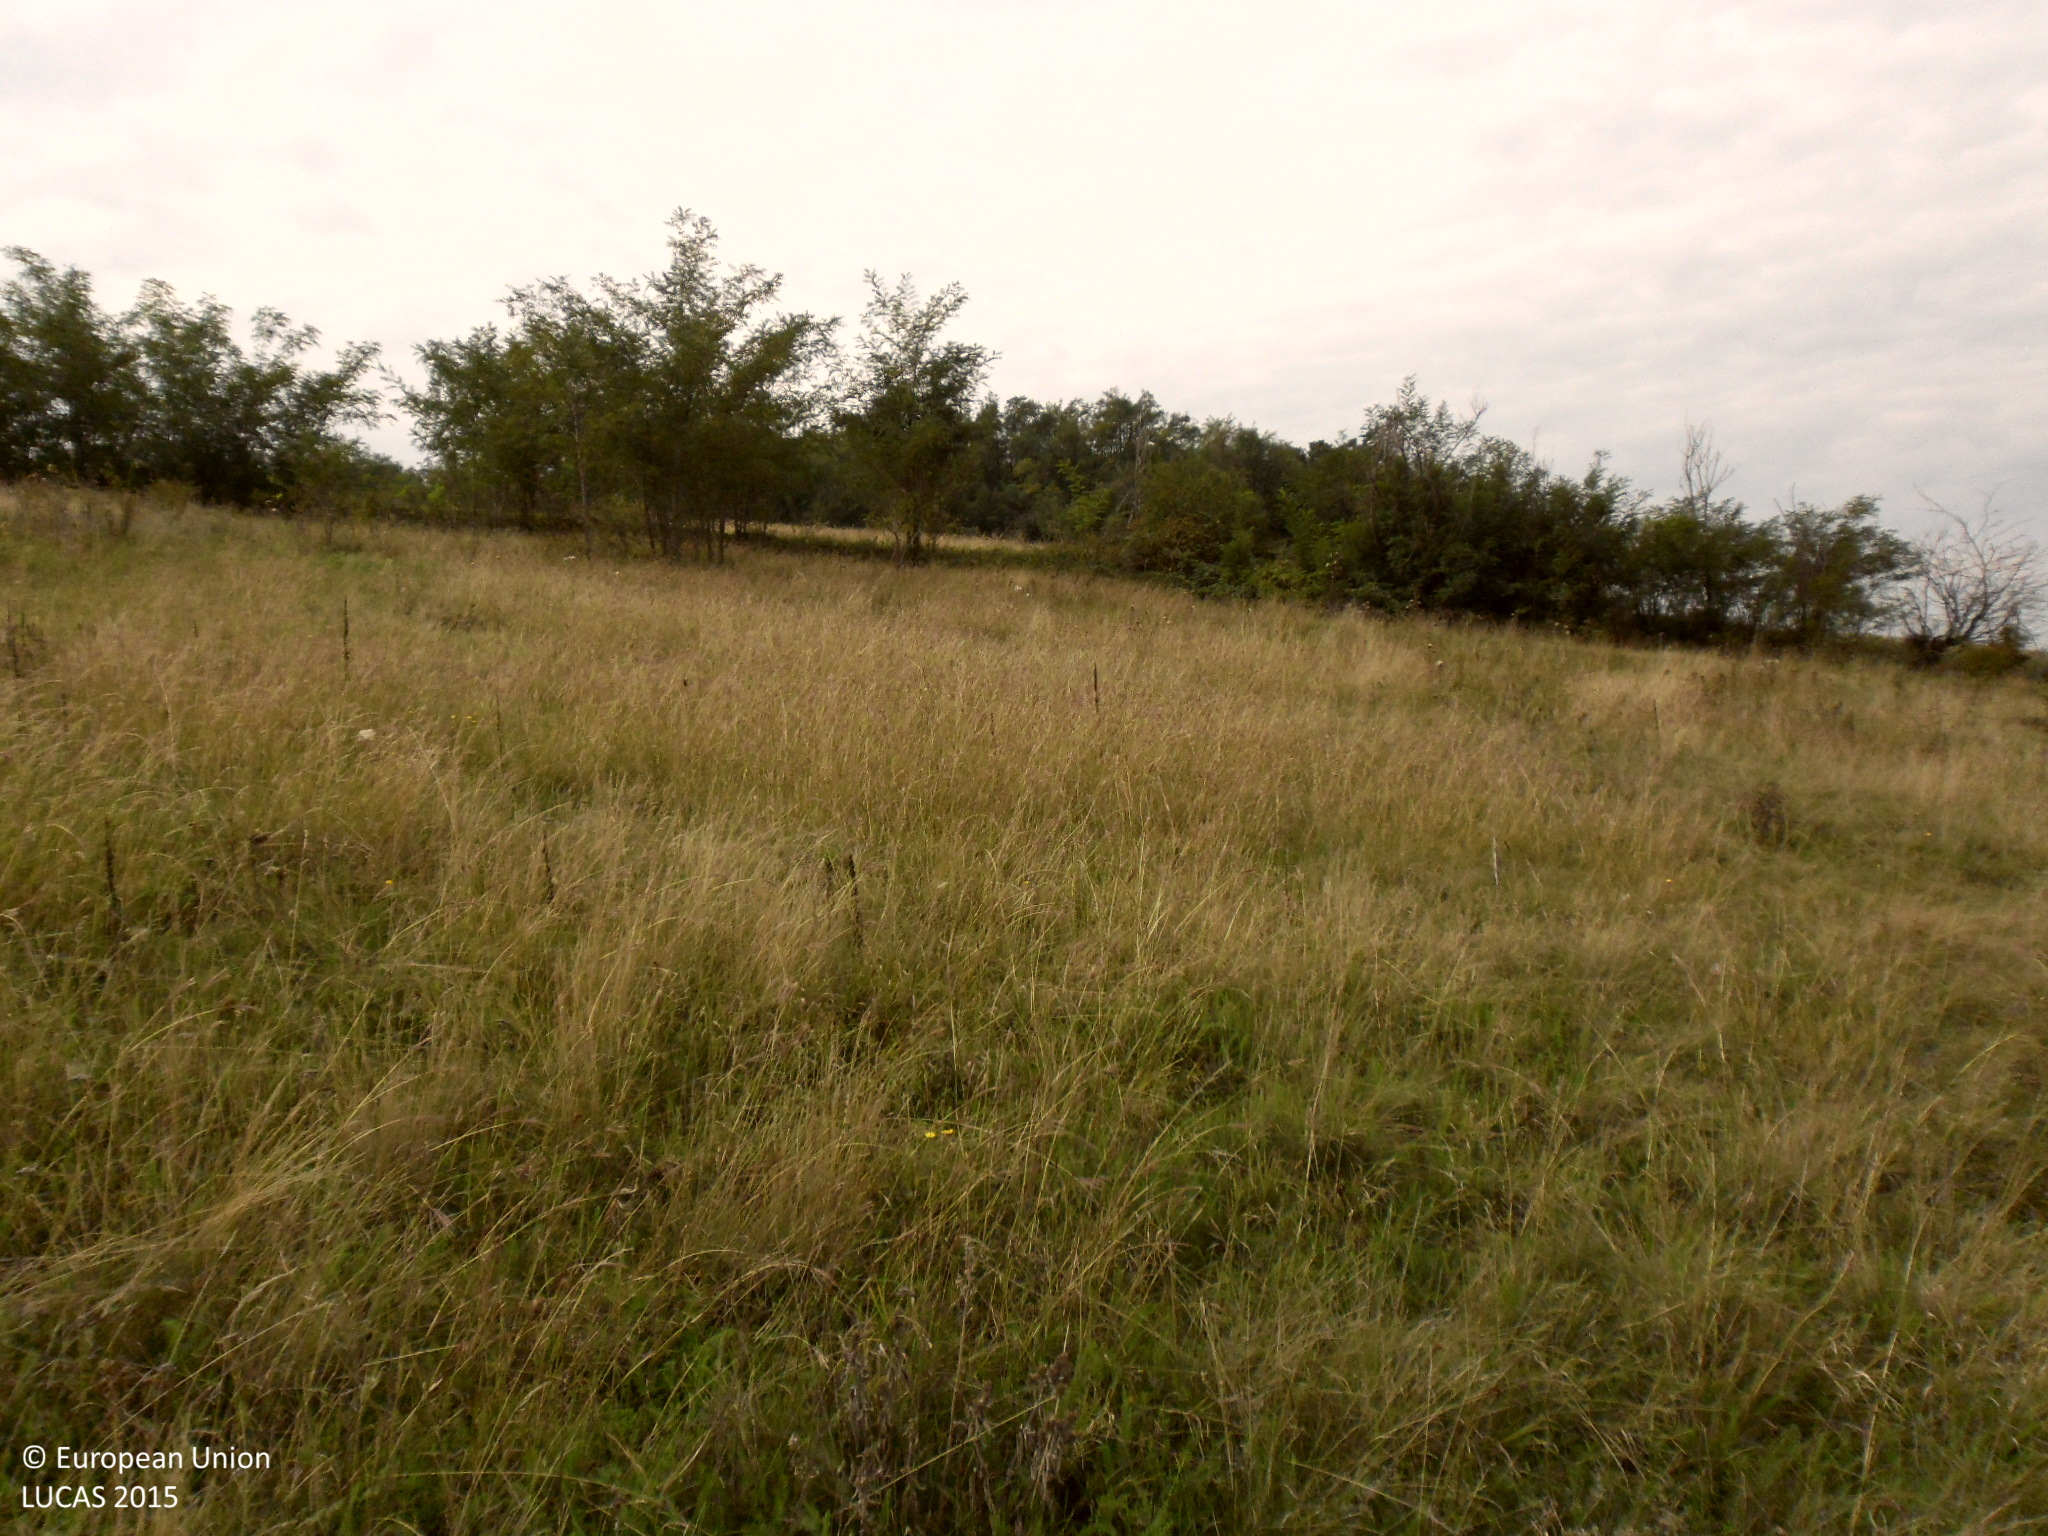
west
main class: Grassland
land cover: Grassland without tree/shrub cover
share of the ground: > 75 %
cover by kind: herbaceous plants 95 %, shrubs 5 %
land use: Agriculture (excluding fallow land and kitchen gardens)
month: October
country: BG
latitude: 44.0110
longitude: 22.6469
